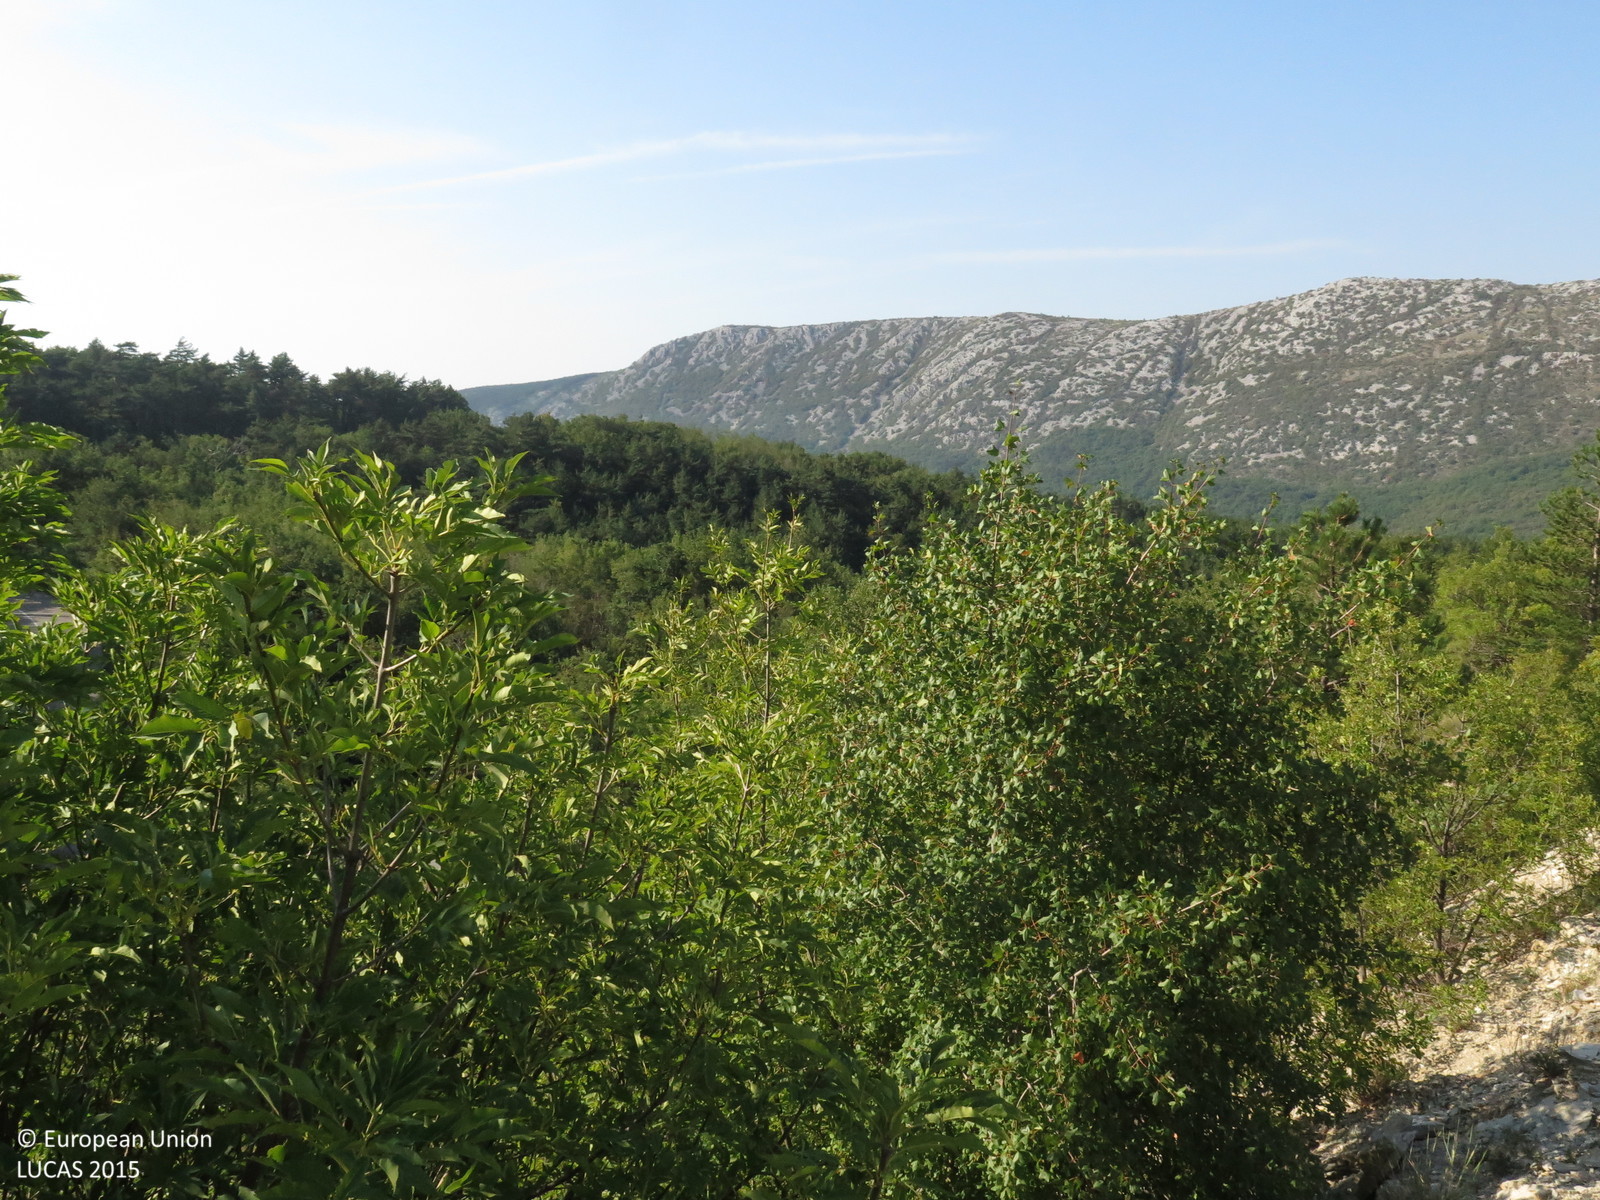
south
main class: Shrubland
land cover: Shrubland with sparse tree cover
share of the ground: 50 - 75 %
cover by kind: shrubs 60 %, herbaceous plants 15 %, unconsolidated bare surface 15 %, broadleaved forest trees 5 %, lichens and mosses 5 %
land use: Semi-natural and natural areas not in use
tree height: < 5 m
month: August
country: HR
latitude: 45.2195
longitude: 14.6938
